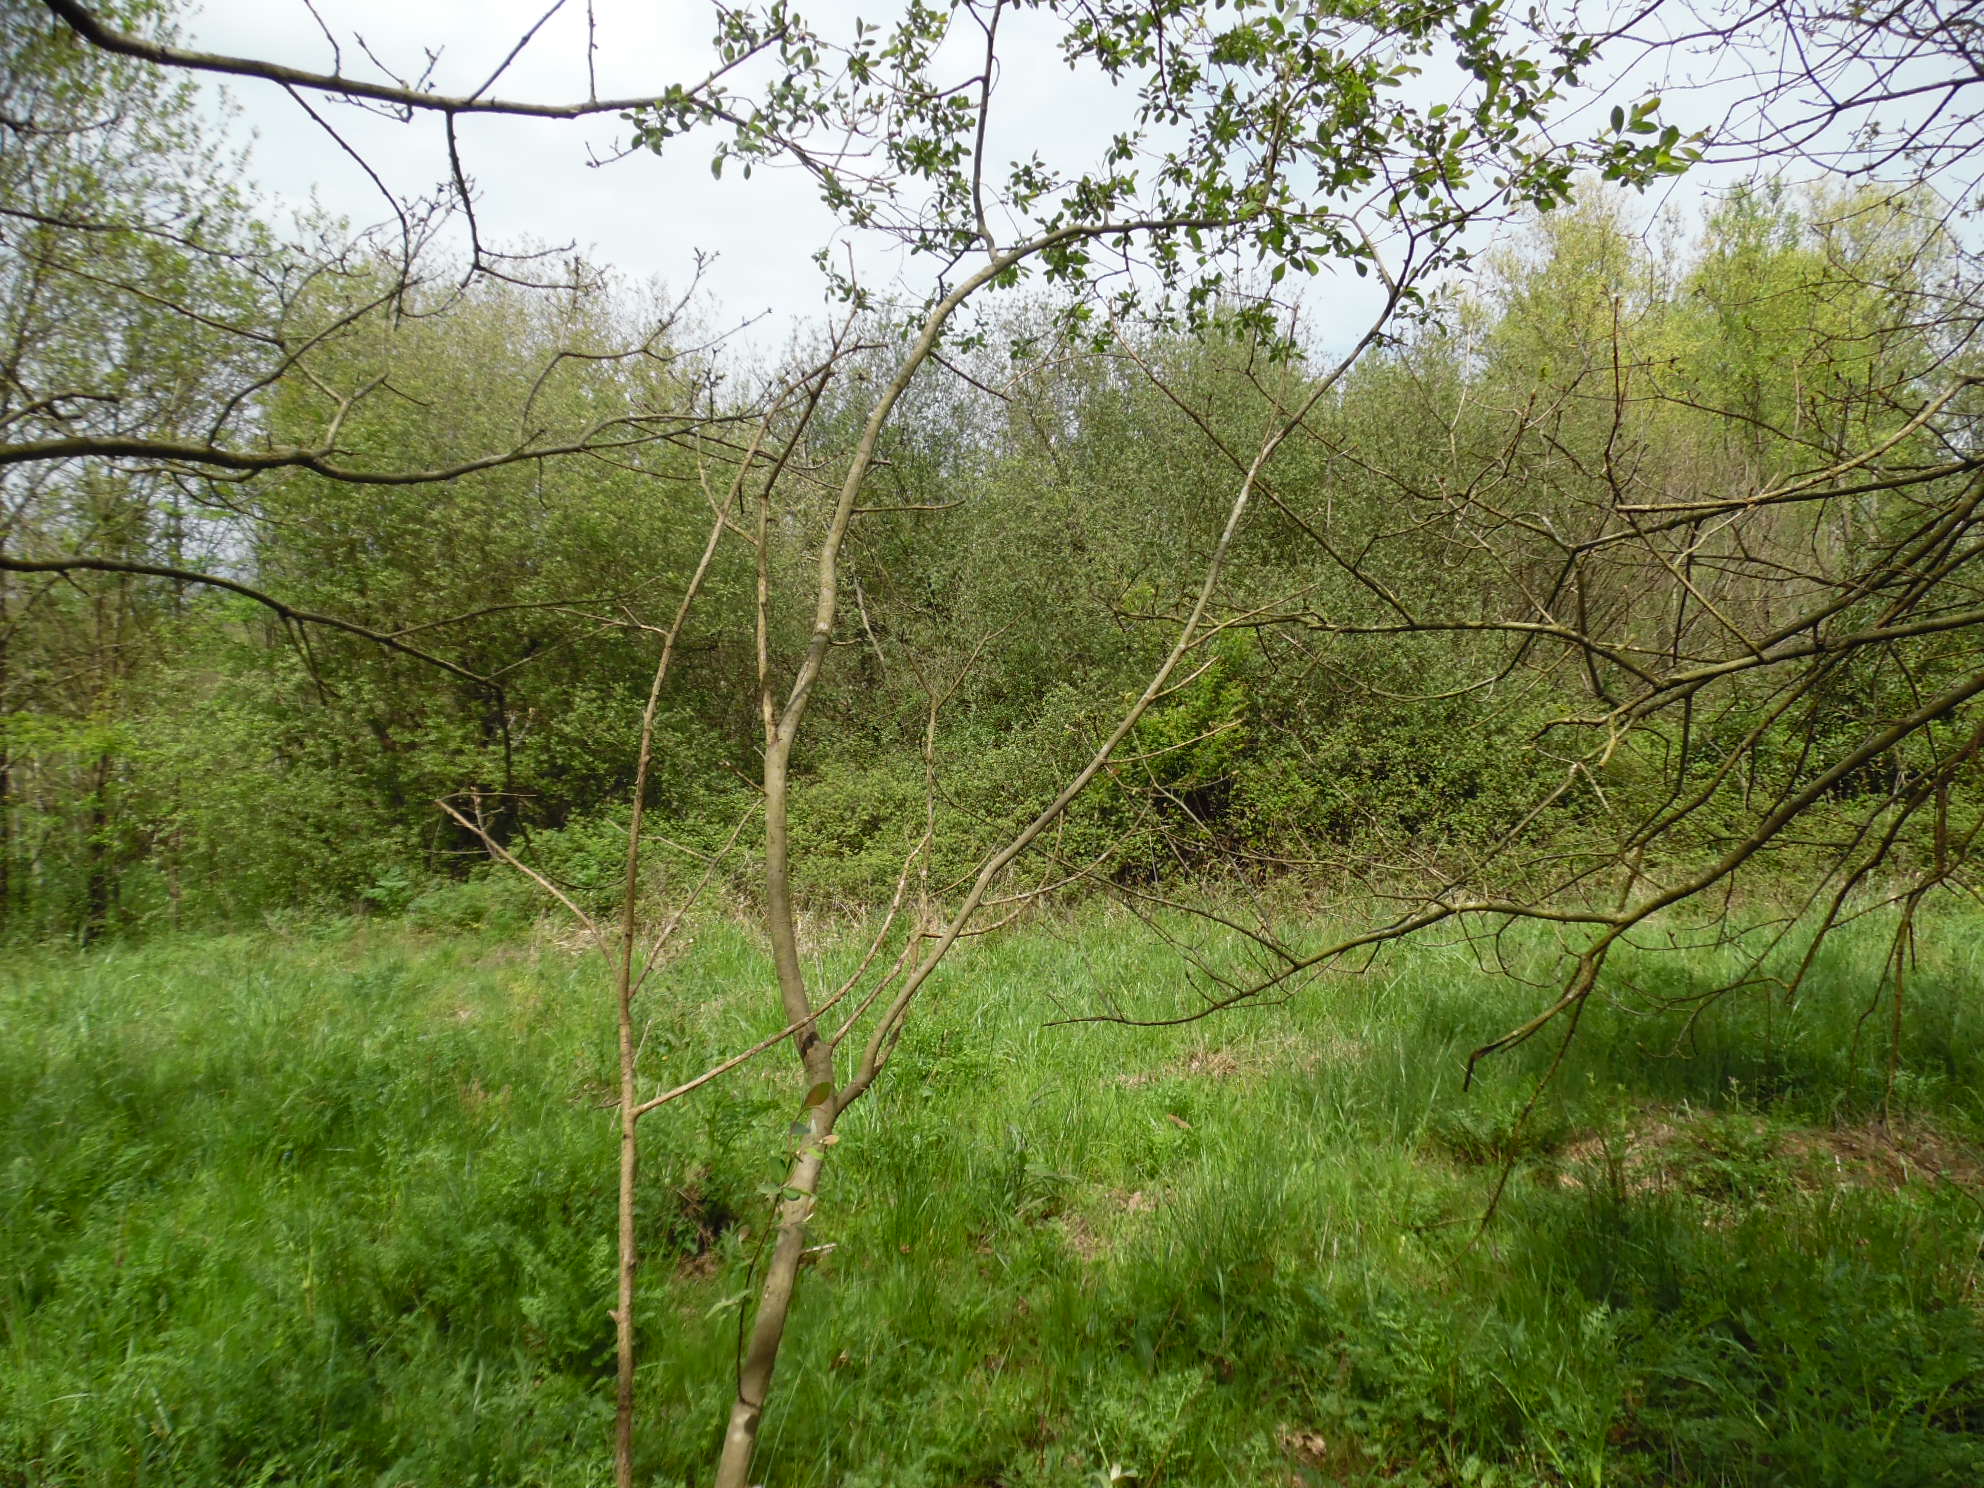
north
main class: Woodland
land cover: Broadleaved woodland
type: floodplain forest
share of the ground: > 75 %
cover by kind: broadleaved forest trees 90 %, shrubs 5 %, herbaceous plants 5 %
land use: Semi-natural and natural areas not in use
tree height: > 5 m
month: April
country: ES
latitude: 43.5245
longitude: -5.8648
